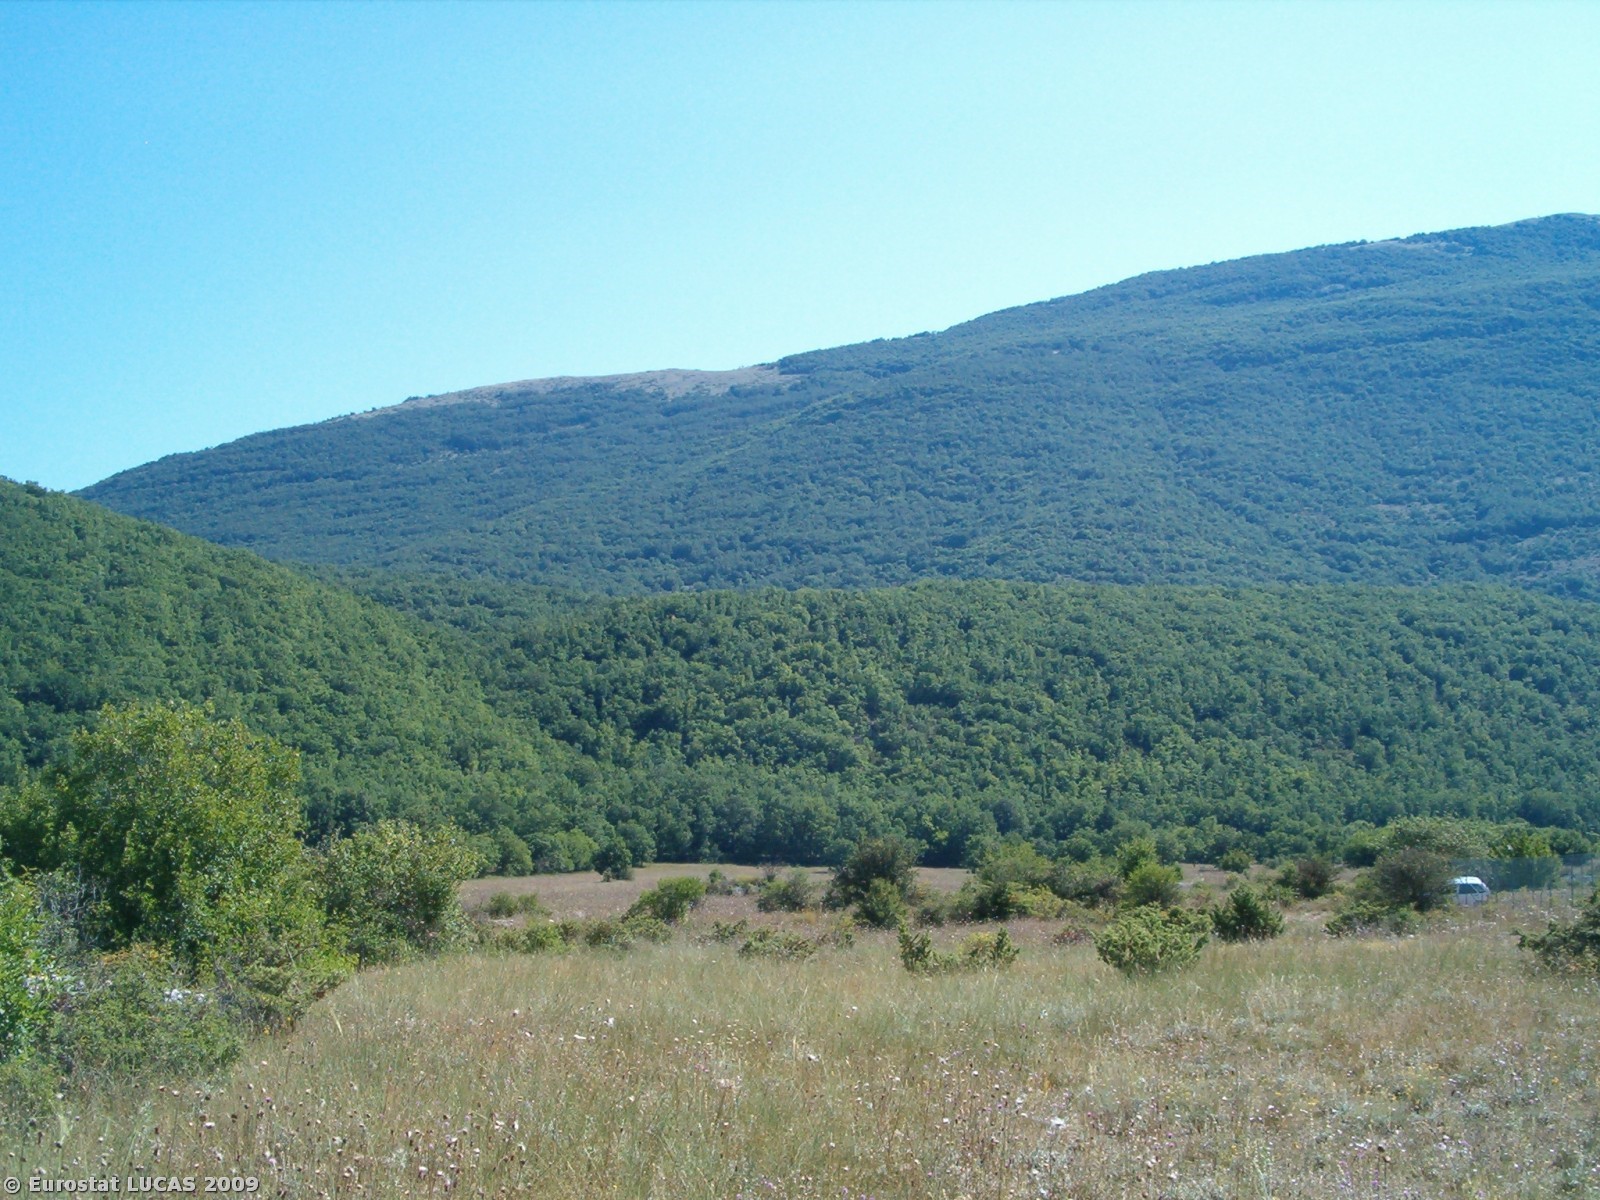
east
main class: Grassland
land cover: Grassland without tree/shrub cover
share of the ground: > 75 %
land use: Agriculture (excluding fallow land and kitchen gardens)
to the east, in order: Grassland without tree/shrub cover; Fences; Abandoned hedges; Bare land; Fences; Tracks; Grassland without tree/shrub cover; Abandoned hedges; Grassland without tree/shrub cover; Abandoned hedges; Grassland without tree/shrub cover; Abandoned hedges; Grassland without tree/shrub cover
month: July
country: IT
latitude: 41.8843
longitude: 13.6146
